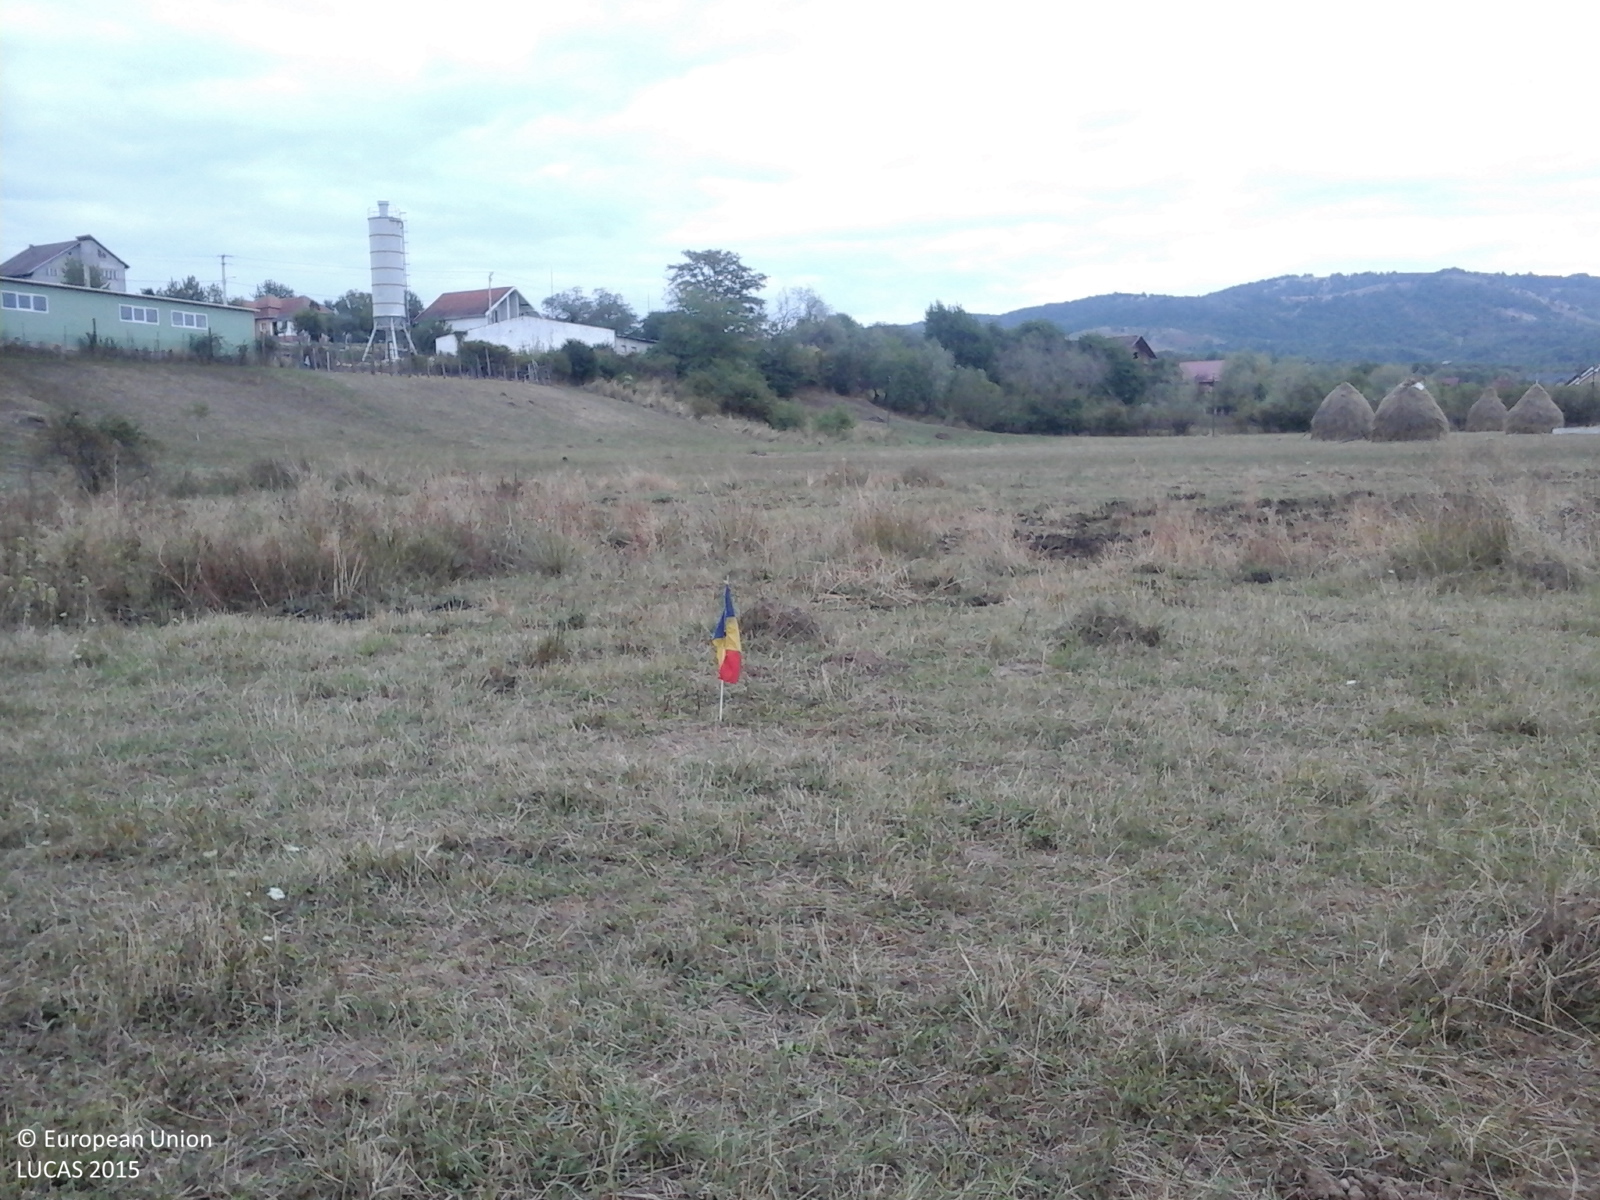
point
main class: Grassland
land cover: Grassland without tree/shrub cover
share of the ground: > 75 %
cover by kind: herbaceous plants 100 %
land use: Agriculture (excluding fallow land and kitchen gardens)
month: September
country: RO
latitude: 47.8536
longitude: 23.4260
